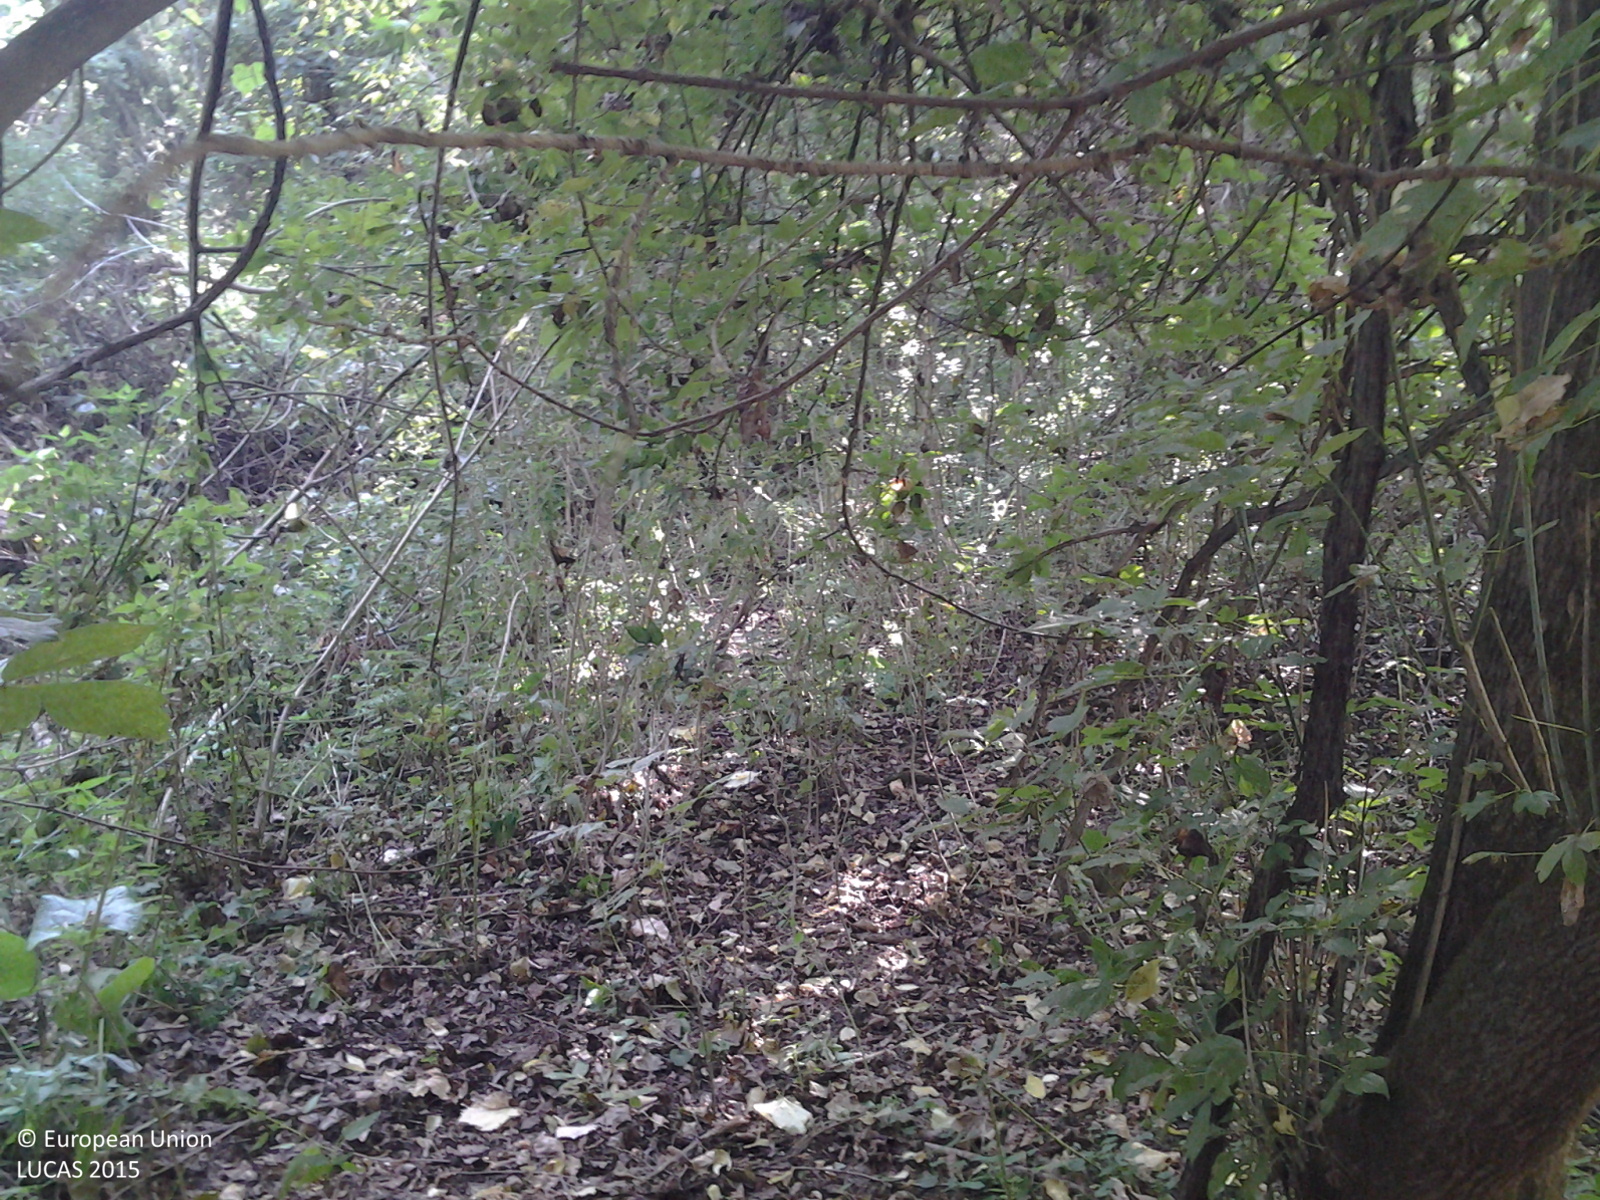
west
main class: Woodland
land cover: Broadleaved woodland
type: mesophytic deciduous forest
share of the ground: > 75 %
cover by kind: broadleaved forest trees 70 %, shrubs 15 %, herbaceous plants 15 %
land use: Forestry
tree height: > 5 m
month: September
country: HU
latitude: 47.4363
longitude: 20.4386
